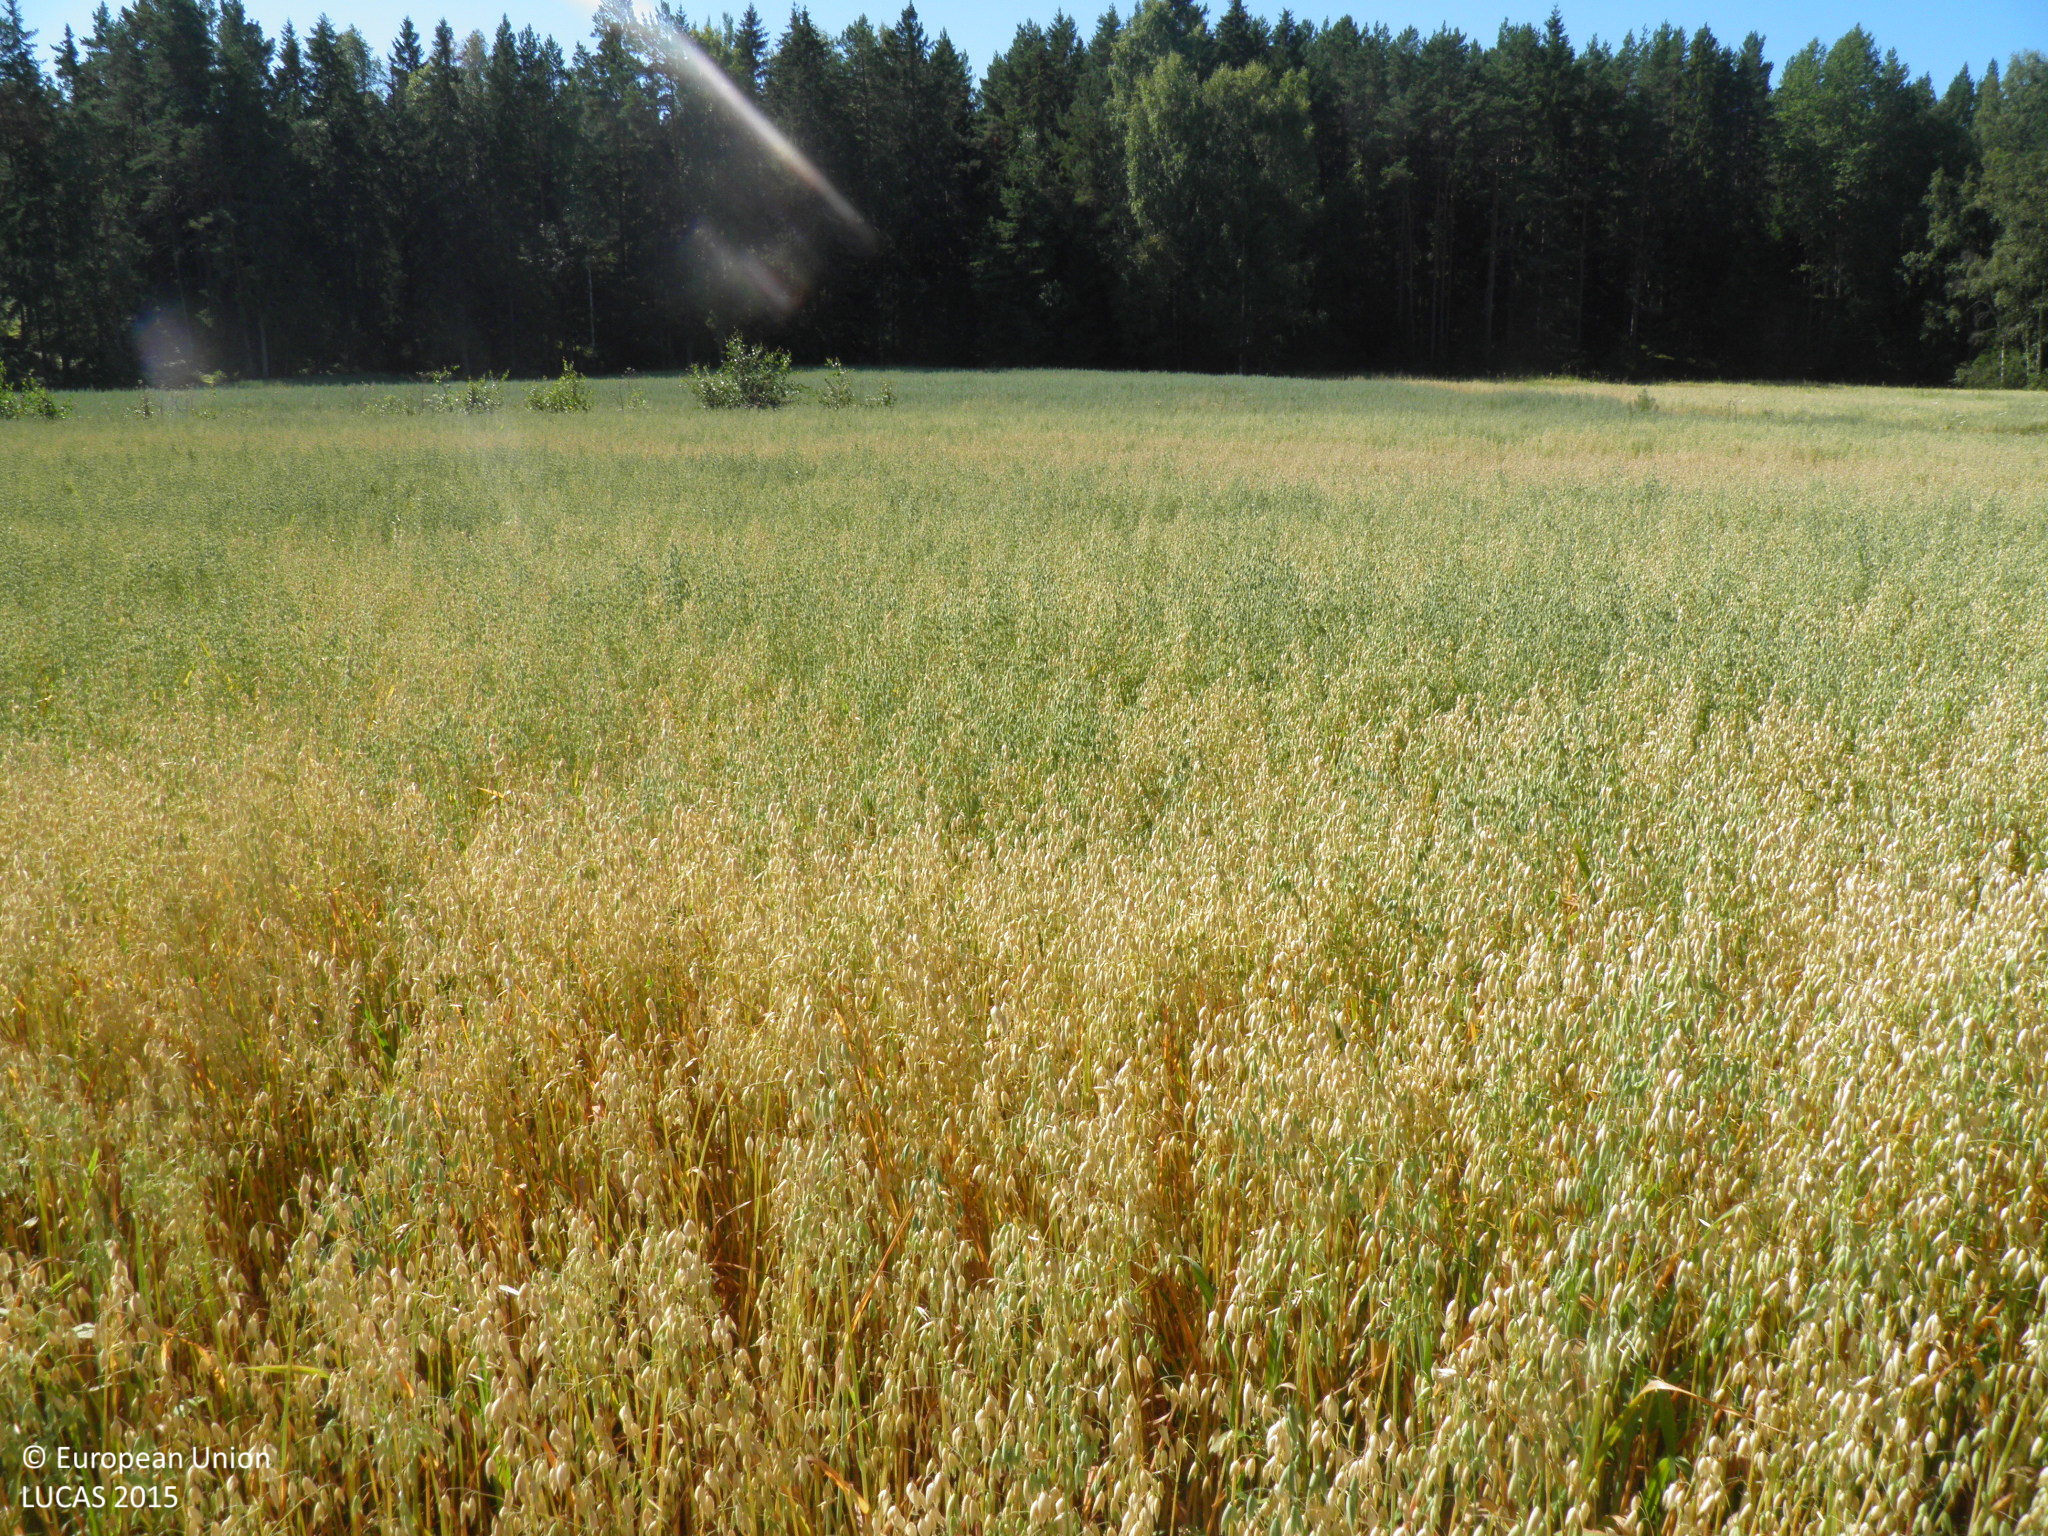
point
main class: Cropland
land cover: Oats
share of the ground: > 75 %
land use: Agriculture (excluding fallow land and kitchen gardens)
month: August
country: FI
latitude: 60.9816
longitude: 21.3060
